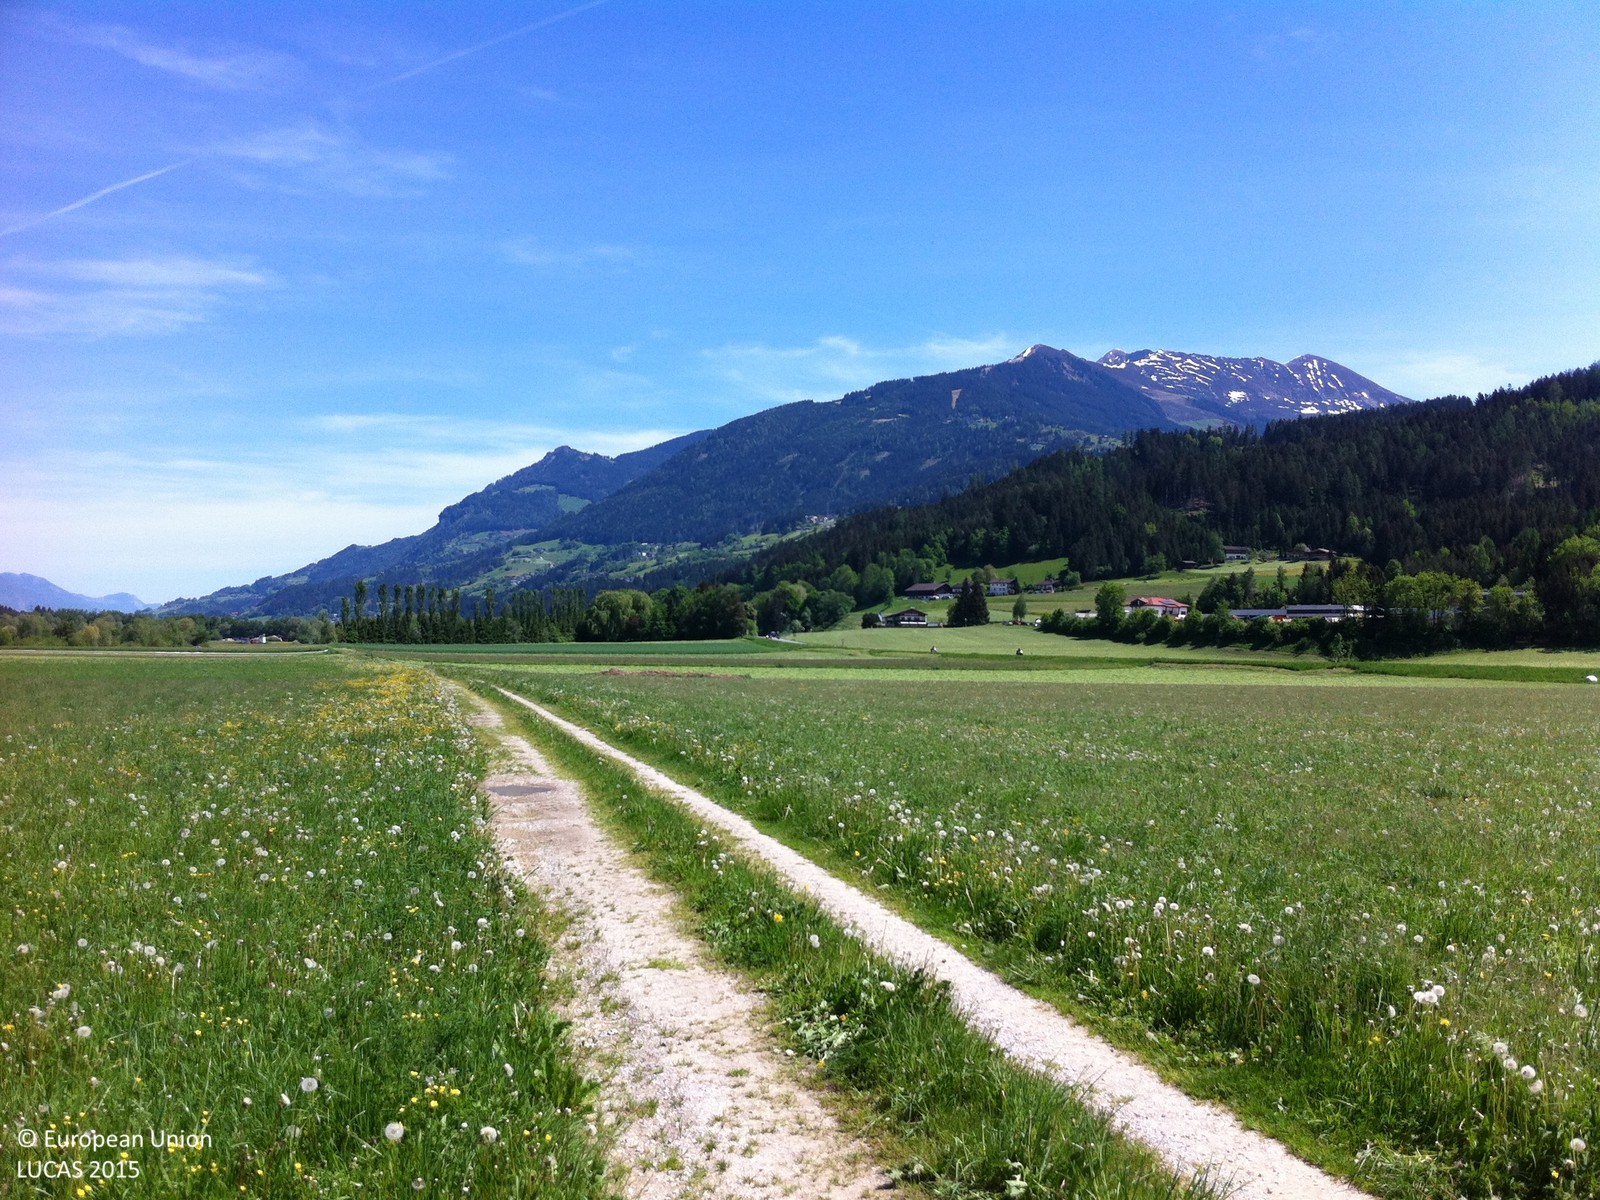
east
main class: Grassland
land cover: Grassland without tree/shrub cover
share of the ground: > 75 %
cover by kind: herbaceous plants 100 %
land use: Agriculture (excluding fallow land and kitchen gardens)
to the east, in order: Grassland without tree/shrub cover; Tracks; Grassland without tree/shrub cover
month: May
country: AT
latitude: 47.3111
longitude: 11.6521
